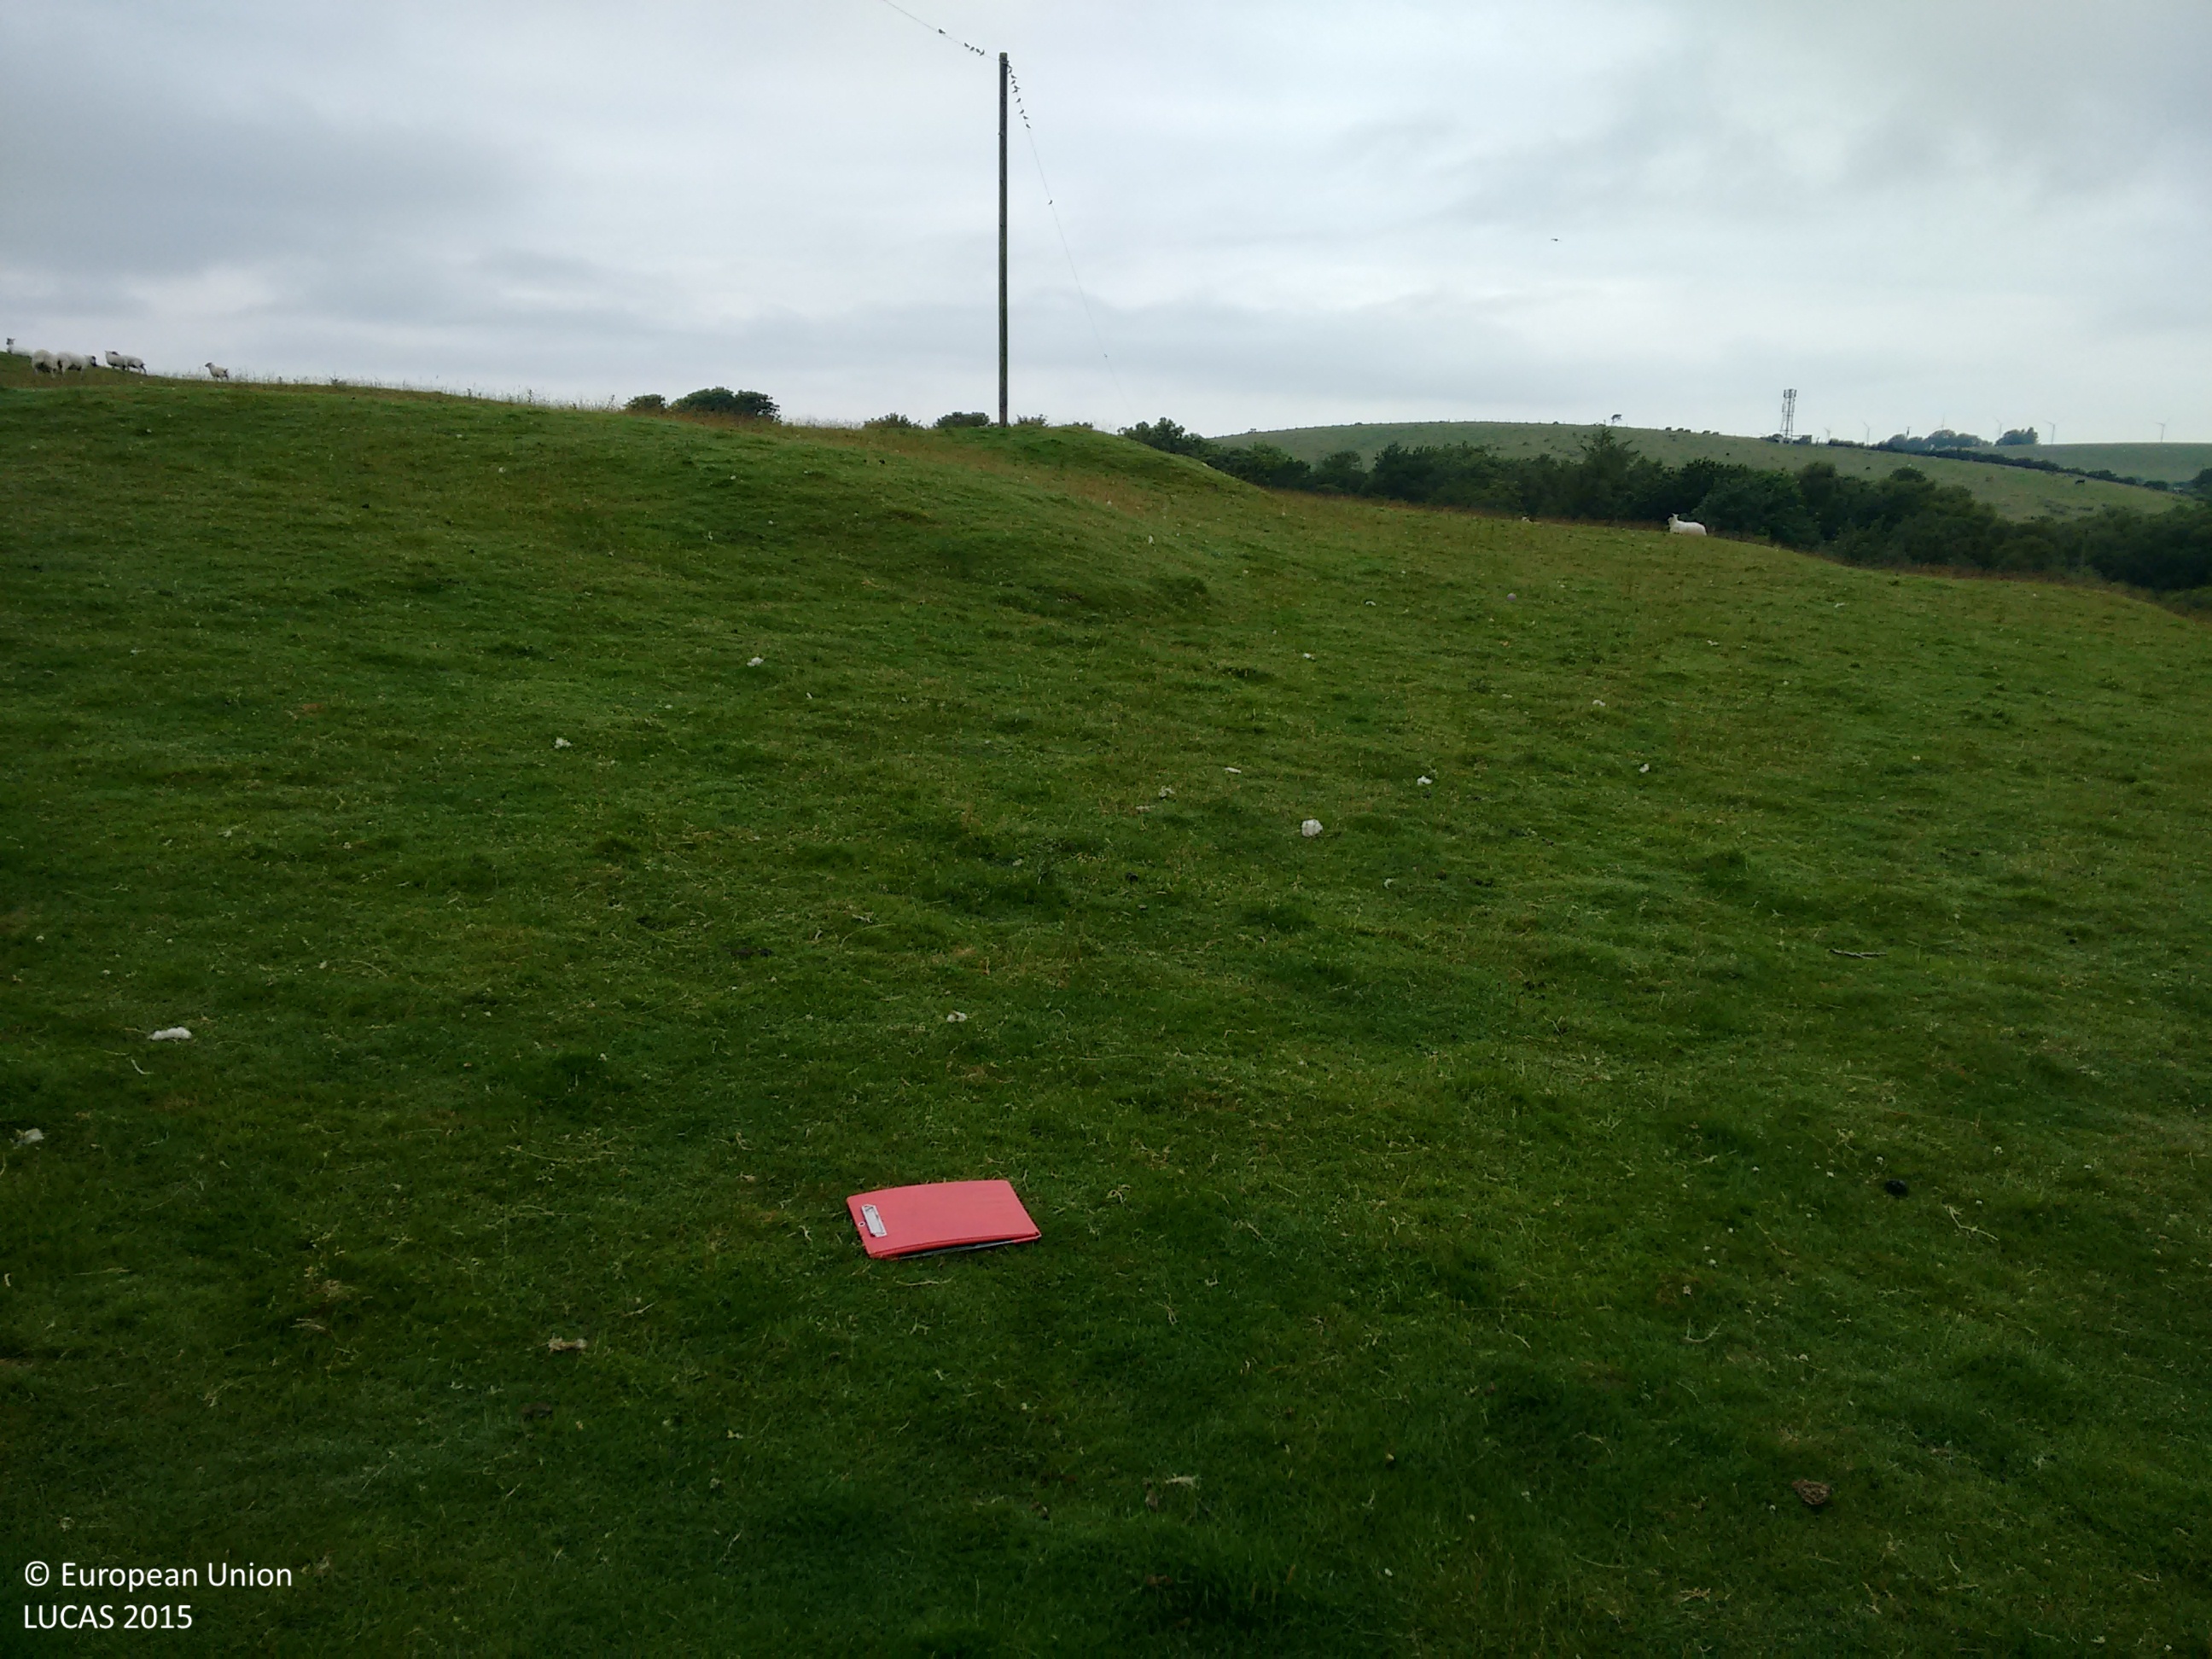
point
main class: Grassland
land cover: Grassland without tree/shrub cover
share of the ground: > 75 %
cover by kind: herbaceous plants 100 %
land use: Agriculture (excluding fallow land and kitchen gardens)
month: August
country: GB
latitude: 54.8932
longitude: -4.7163
